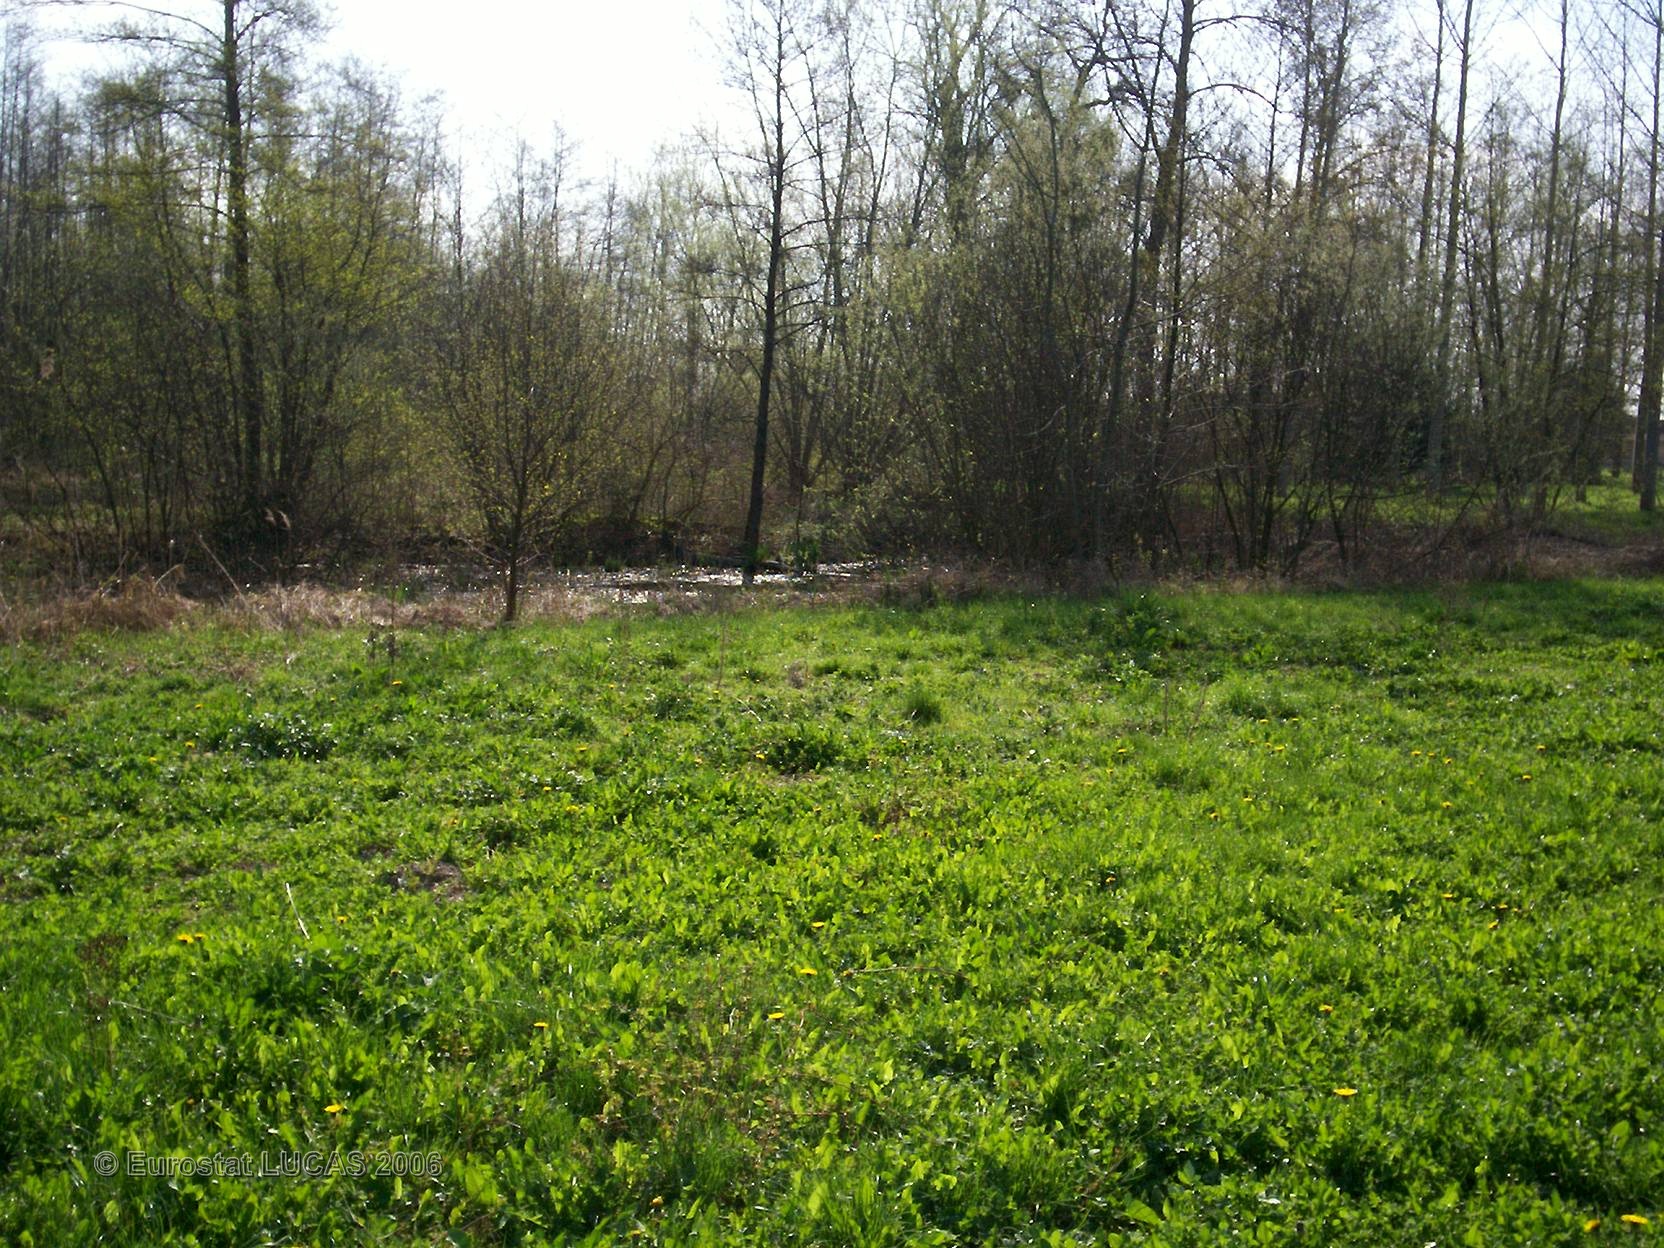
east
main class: Grassland
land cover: Grassland without tree/shrub cover
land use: Agriculture (excluding fallow land and kitchen gardens)
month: April
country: FR
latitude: 48.5171
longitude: 4.4600
